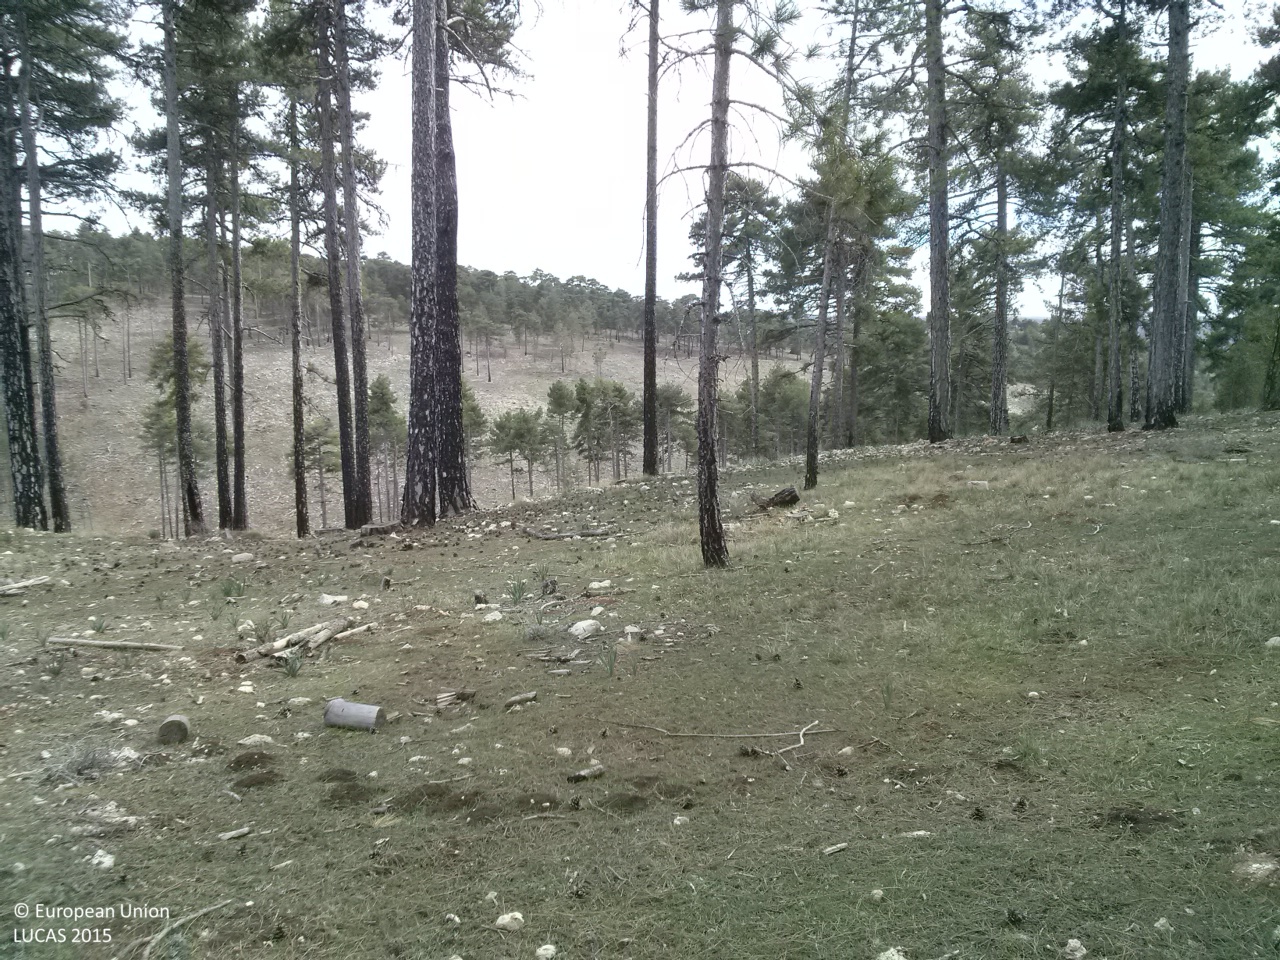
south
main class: Woodland
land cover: Pine dominated coniferous woodland
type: coniferous forest of the mediterranean region
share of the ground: 10 - 25 %
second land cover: Grassland without tree/shrub cover
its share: > 75 %
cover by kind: herbaceous plants 80 %, coniferous forest trees 20 %
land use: Forestry
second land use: Agriculture (excluding fallow land and kitchen gardens)
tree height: > 5 m
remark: Burnt area
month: April
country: ES
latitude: 40.2854
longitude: -1.9317
